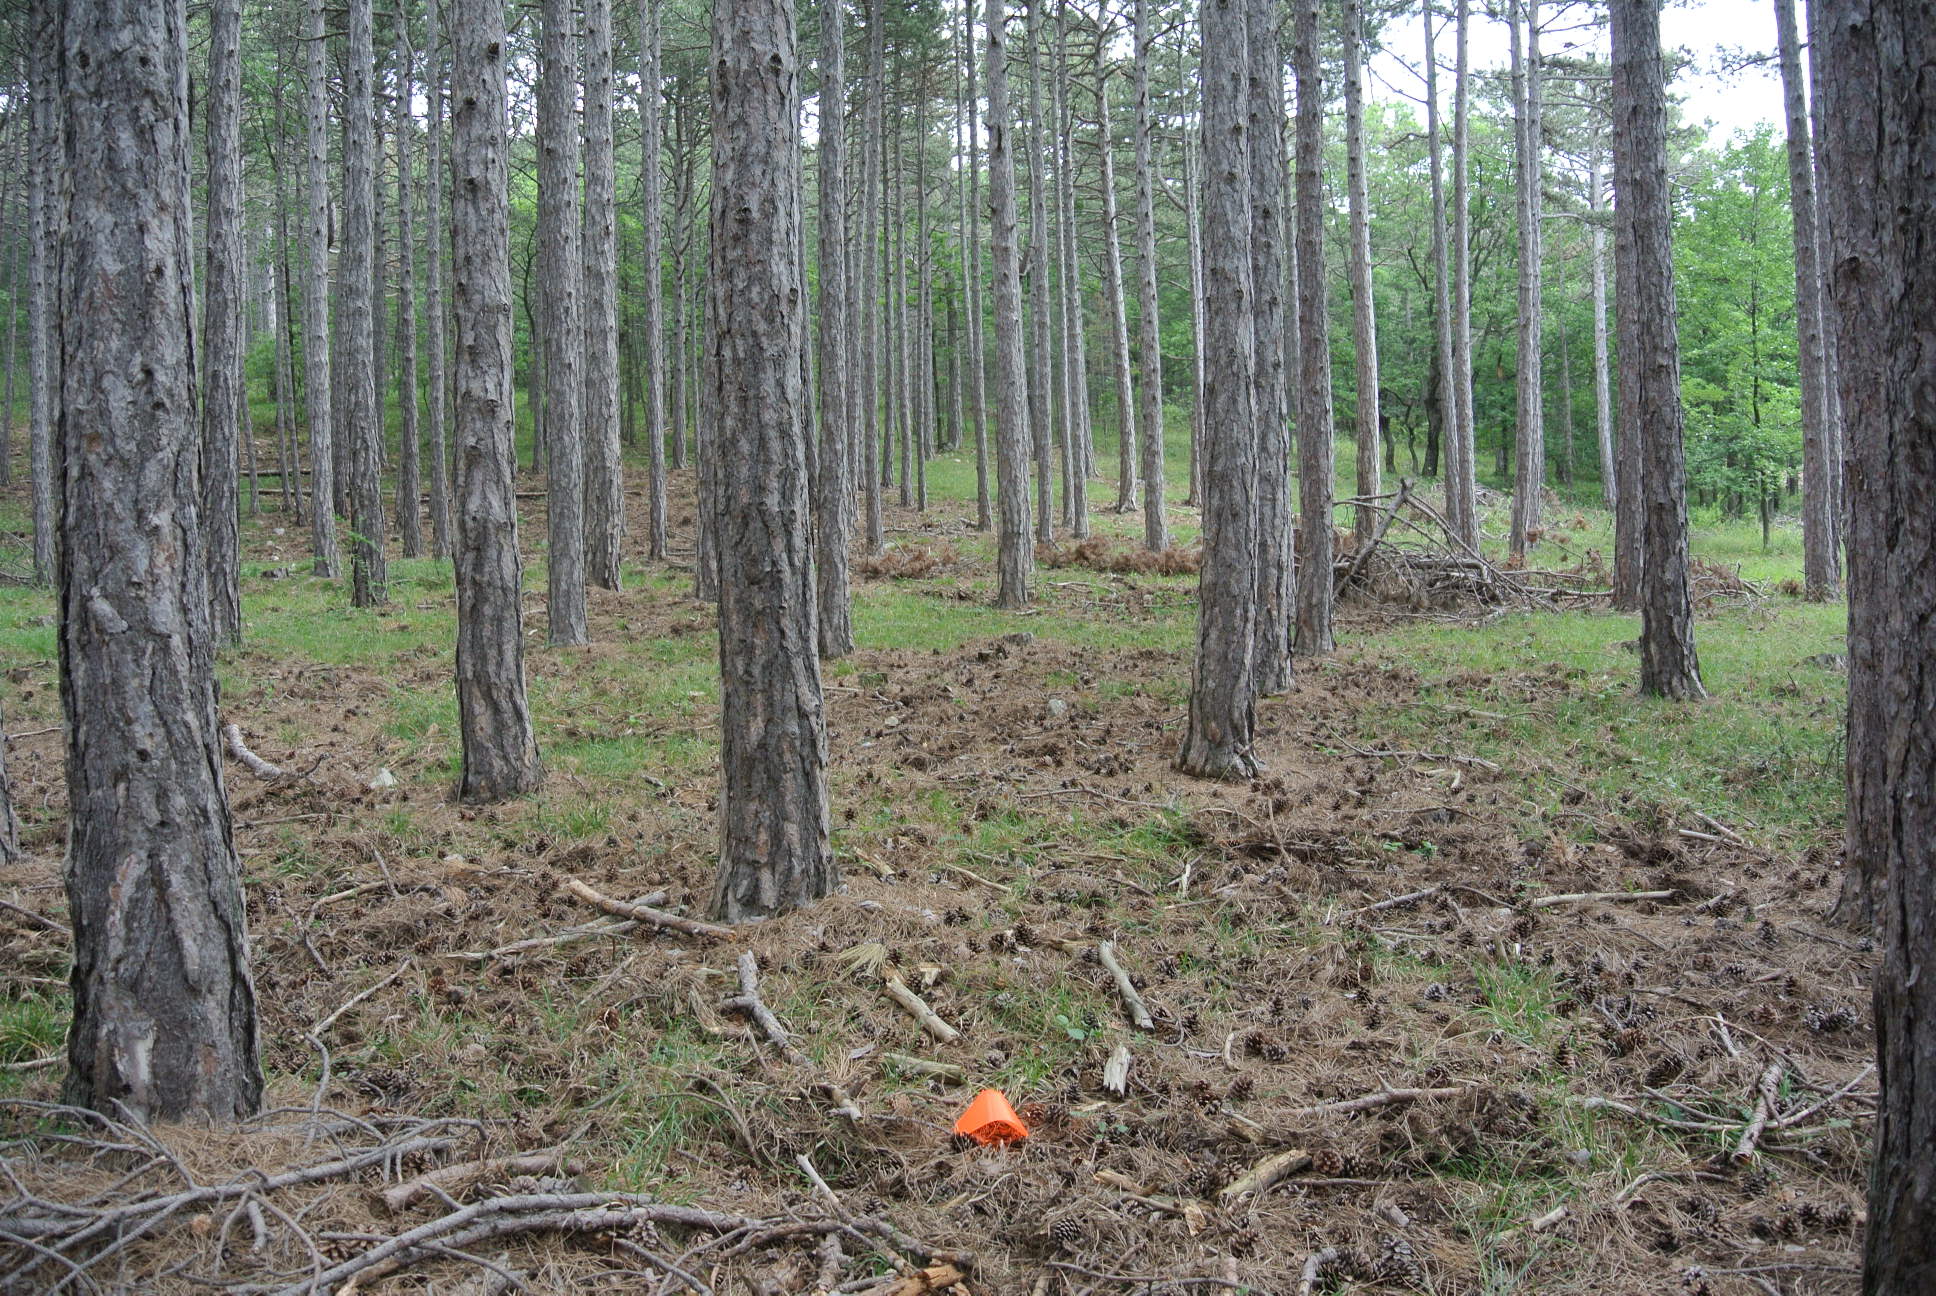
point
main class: Woodland
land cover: Pine dominated coniferous woodland
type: alpine coniferous forest
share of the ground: > 75 %
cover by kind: coniferous forest trees 85 %, herbaceous plants 15 %
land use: Forestry
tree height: > 5 m
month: May
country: AT
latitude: 47.8196
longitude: 16.1071
